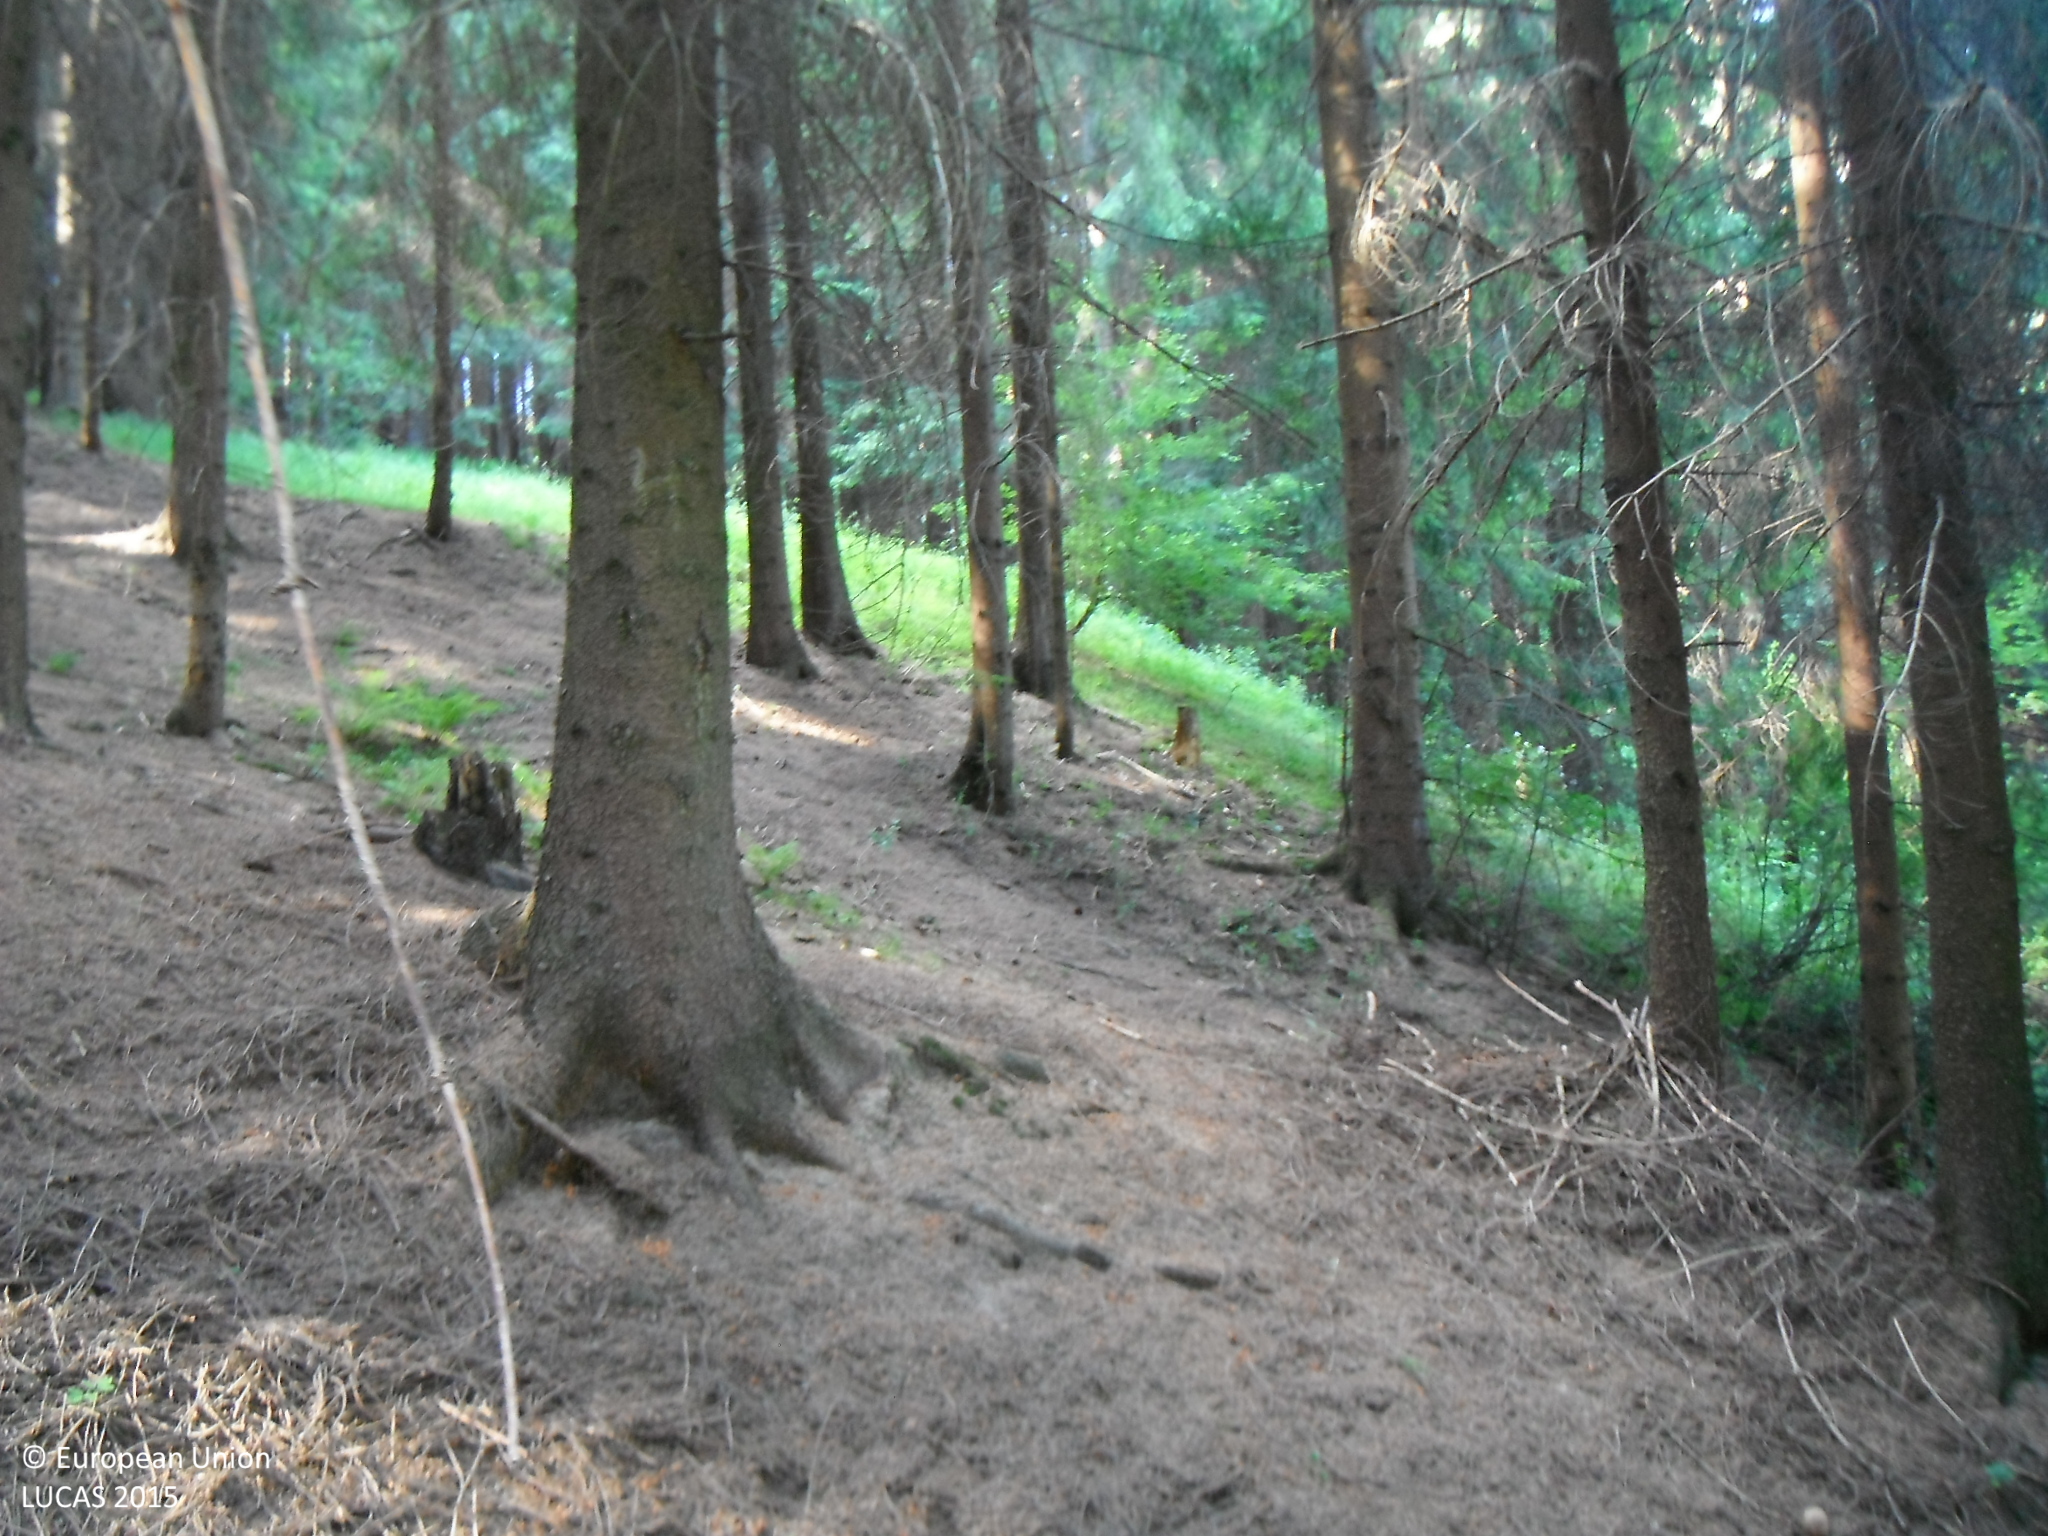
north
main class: Woodland
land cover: Spruce dominated coniferous woodland
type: alpine coniferous forest
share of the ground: > 75 %
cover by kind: coniferous forest trees 95 %, unconsolidated bare surface 5 %
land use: Forestry
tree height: > 5 m
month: July
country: SK
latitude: 49.3884
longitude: 18.6019
